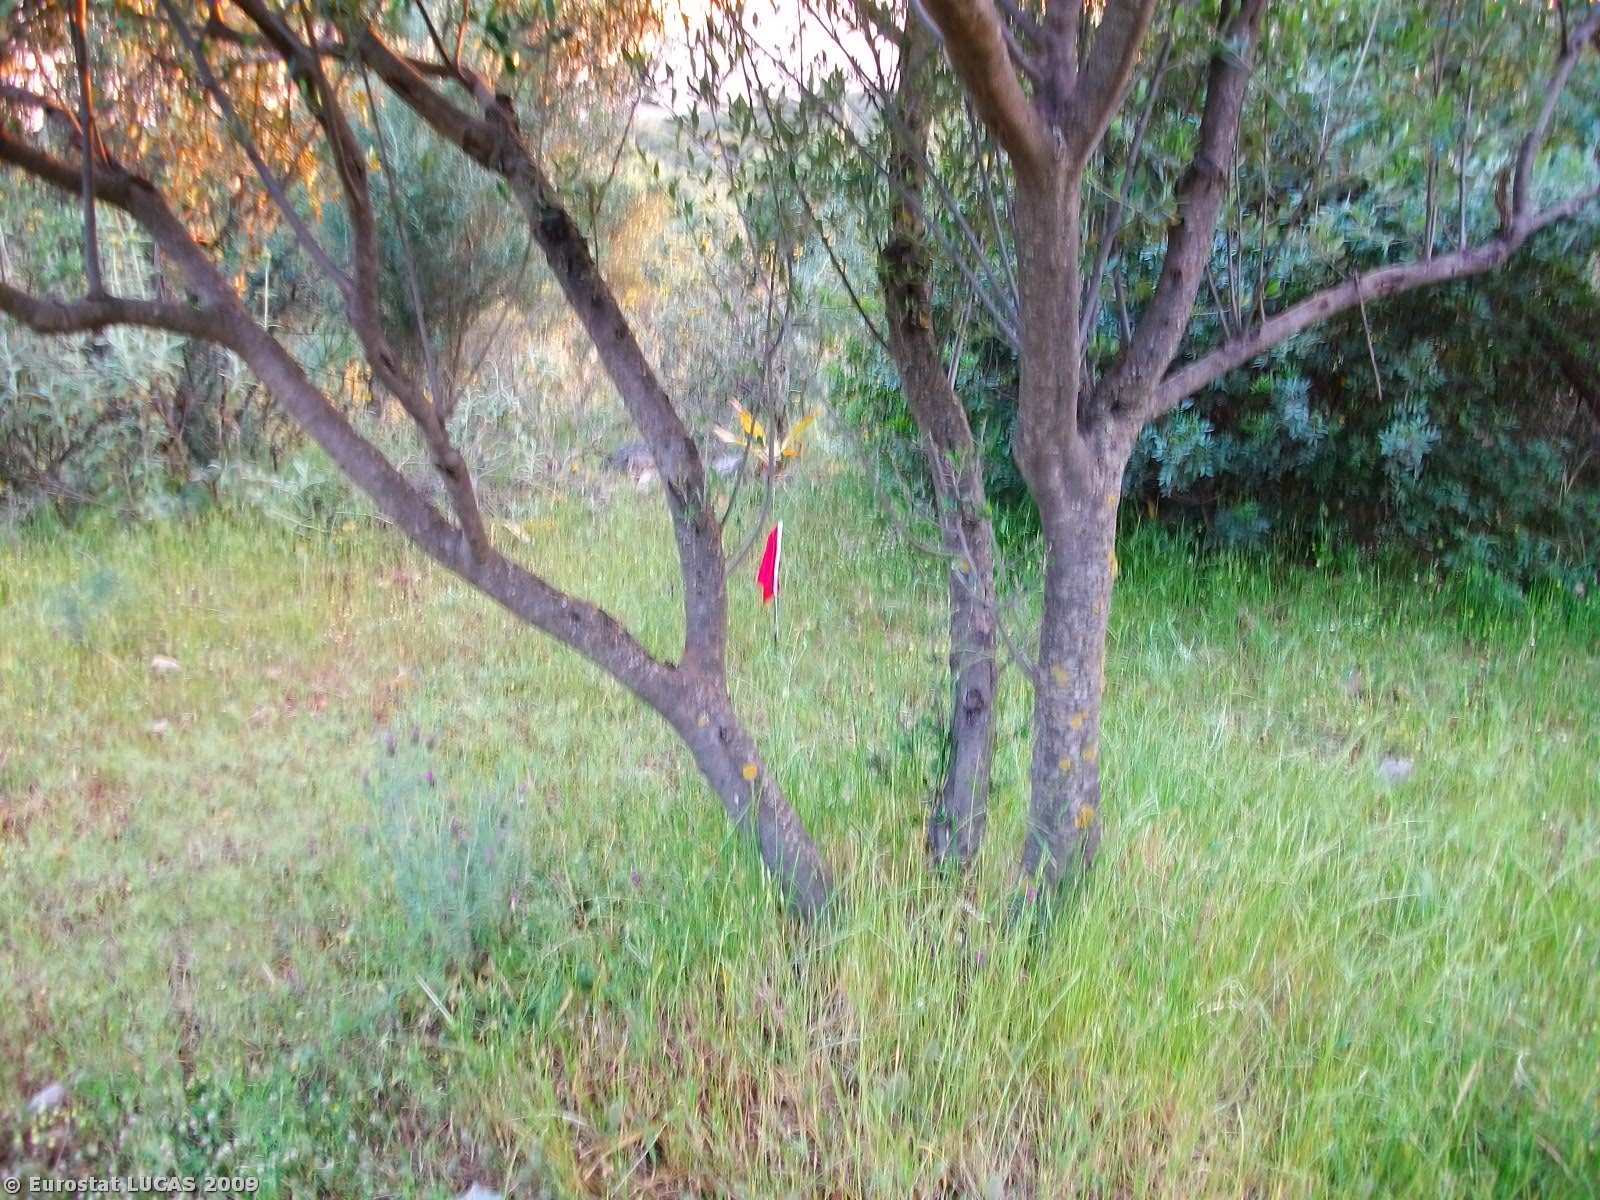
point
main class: Cropland
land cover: Olive groves
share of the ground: 50 - 75 %
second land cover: Grassland with sparse tree/shrub cover
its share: 50 - 75 %
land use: Agriculture (excluding fallow land and kitchen gardens)
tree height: < 5 m
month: May
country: GR
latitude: 37.1838
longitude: 22.0190
